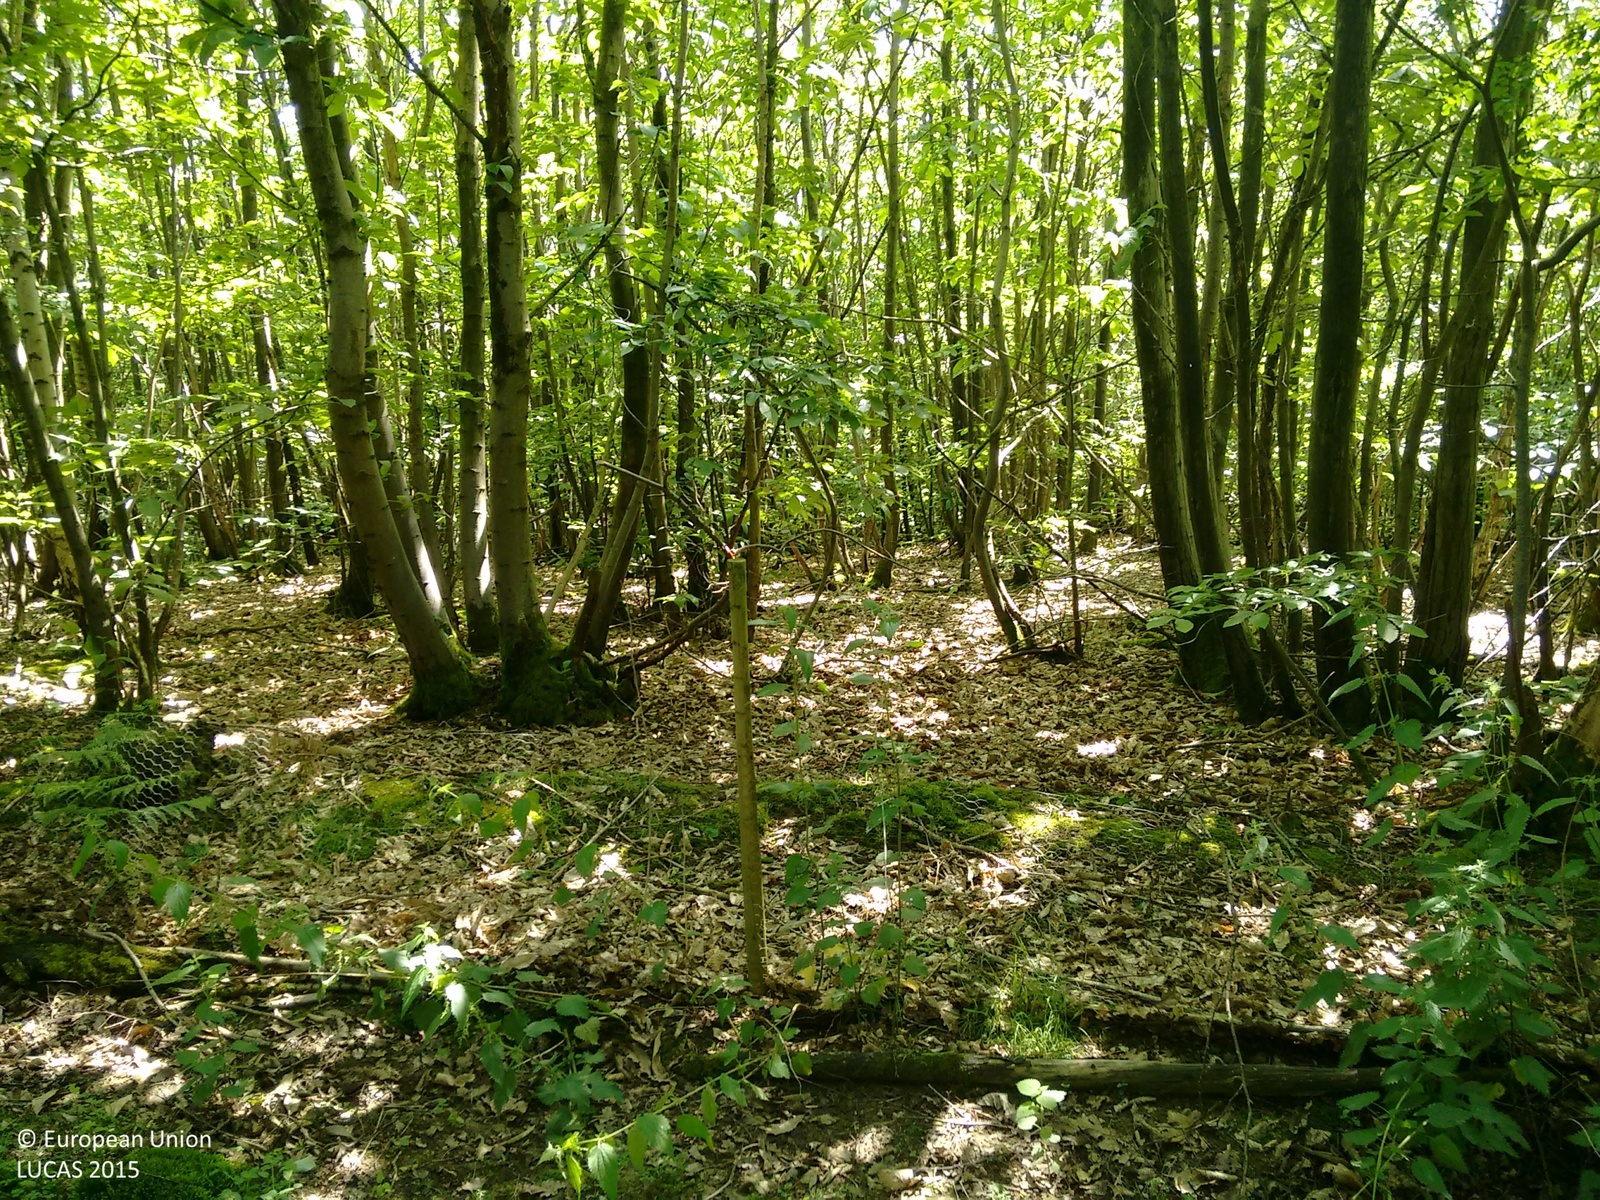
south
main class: Woodland
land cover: Broadleaved woodland
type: mesophytic deciduous forest
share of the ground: > 75 %
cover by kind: broadleaved forest trees 75 %, coniferous forest trees 15 %, shrubs 5 %, herbaceous plants 5 %
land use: Forestry
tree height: > 5 m
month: June
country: GB
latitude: 51.0445
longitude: 0.6021
